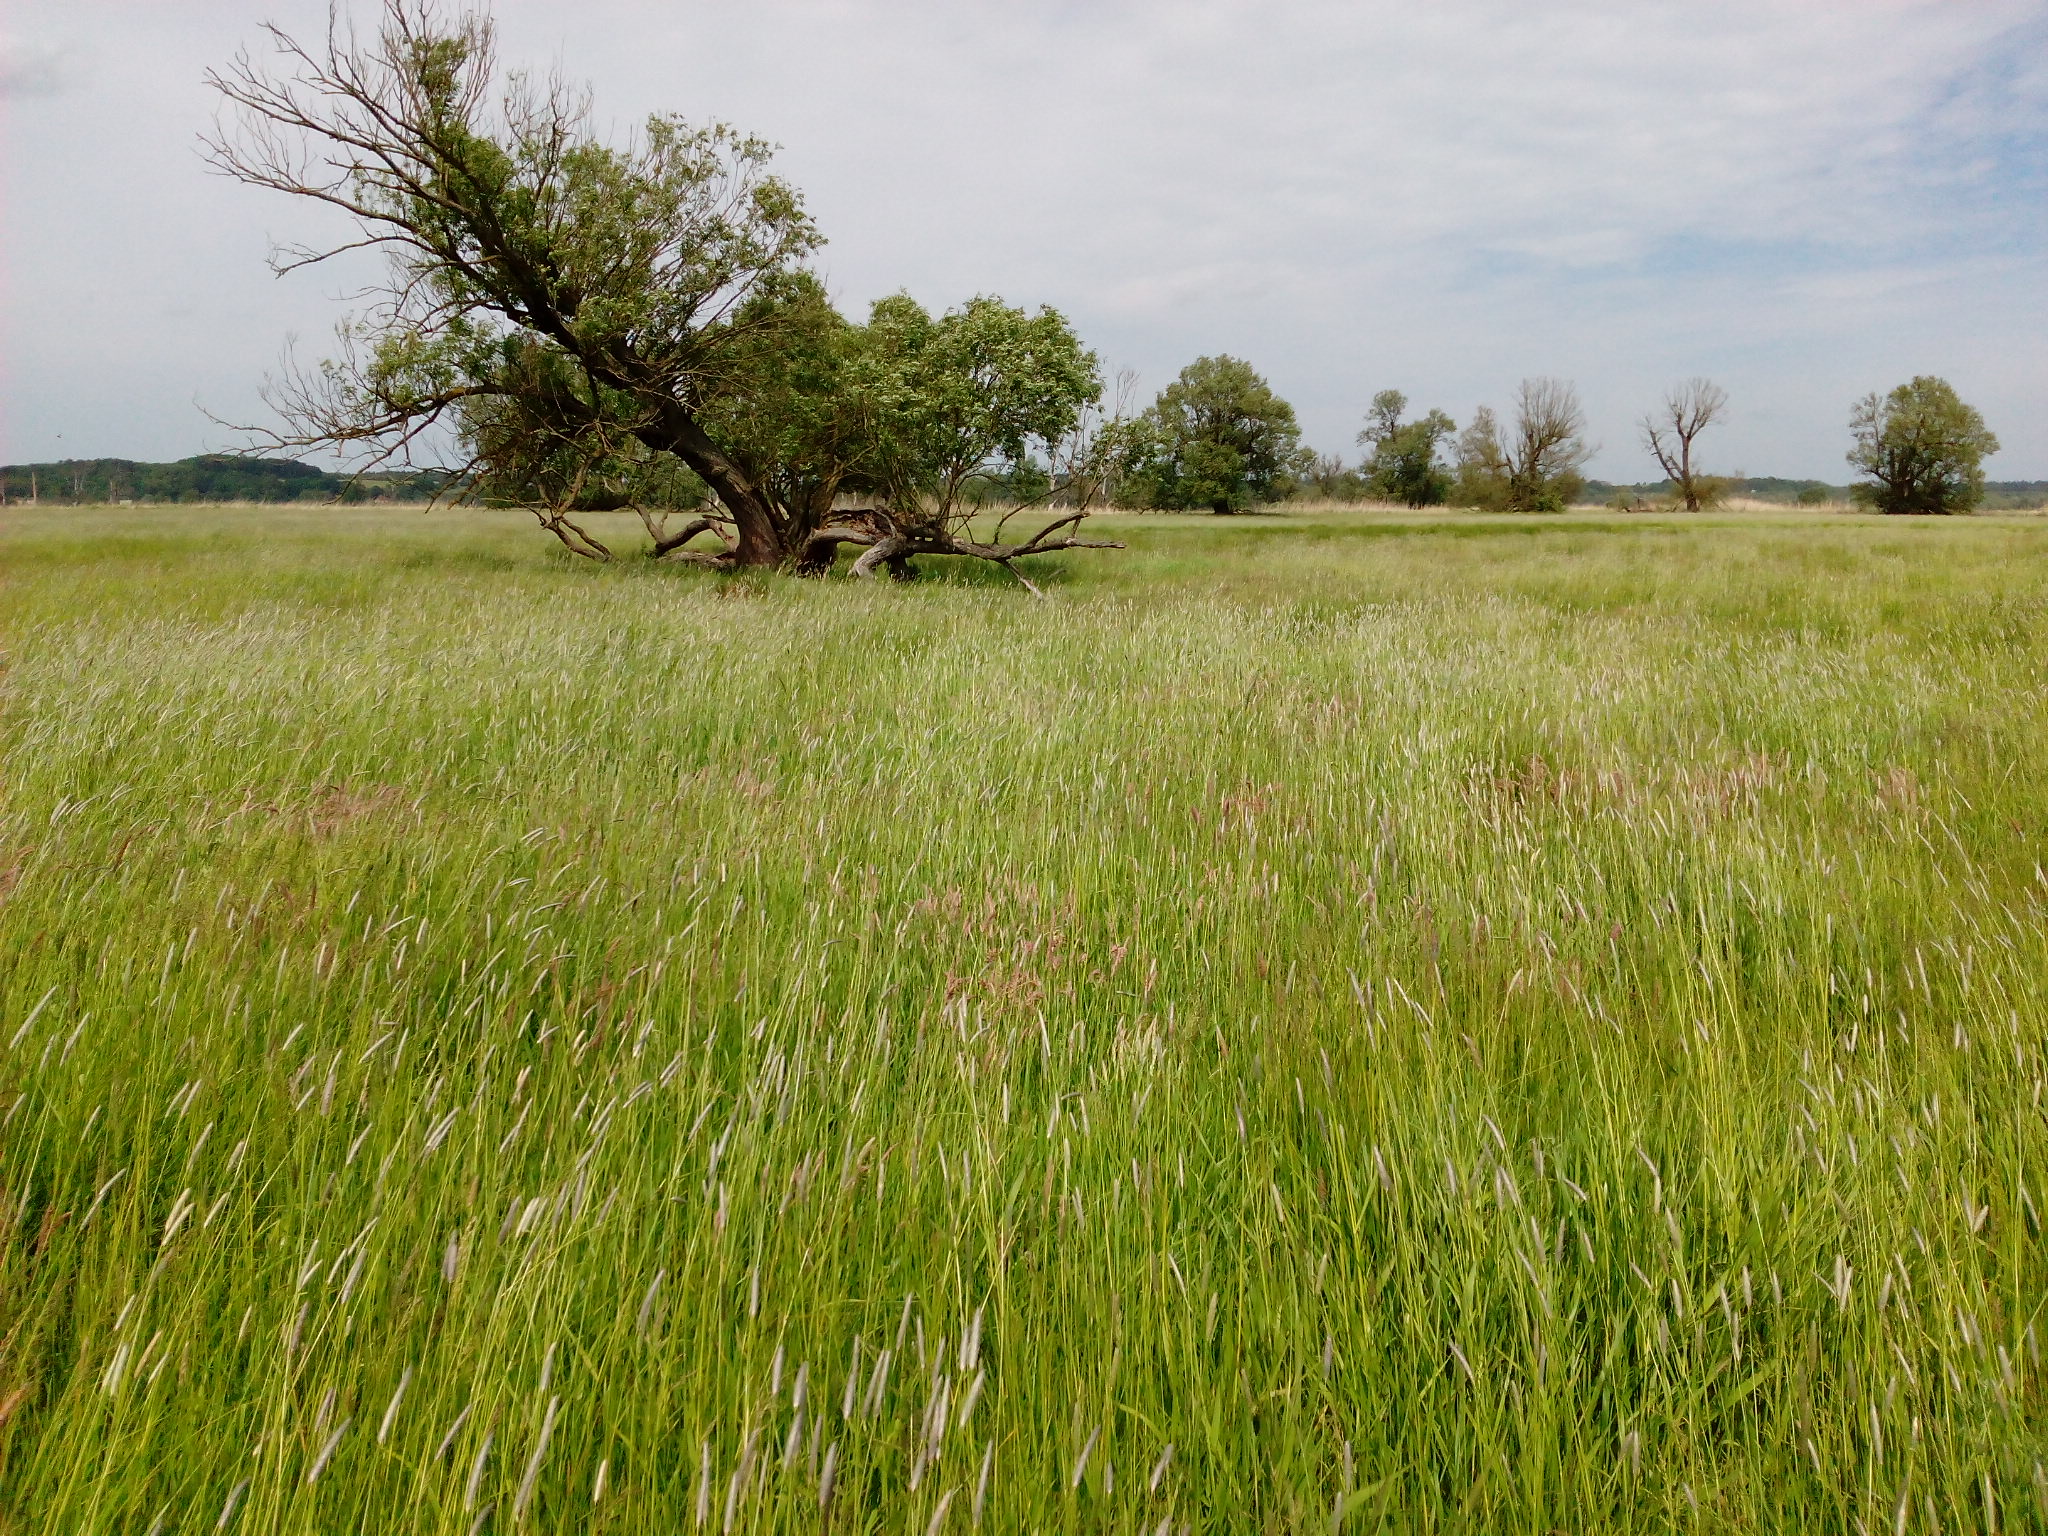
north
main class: Grassland
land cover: Grassland without tree/shrub cover
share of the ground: > 75 %
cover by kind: herbaceous plants 100 %
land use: Agriculture (excluding fallow land and kitchen gardens)
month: June
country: DE
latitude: 52.9707
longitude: 14.1553
